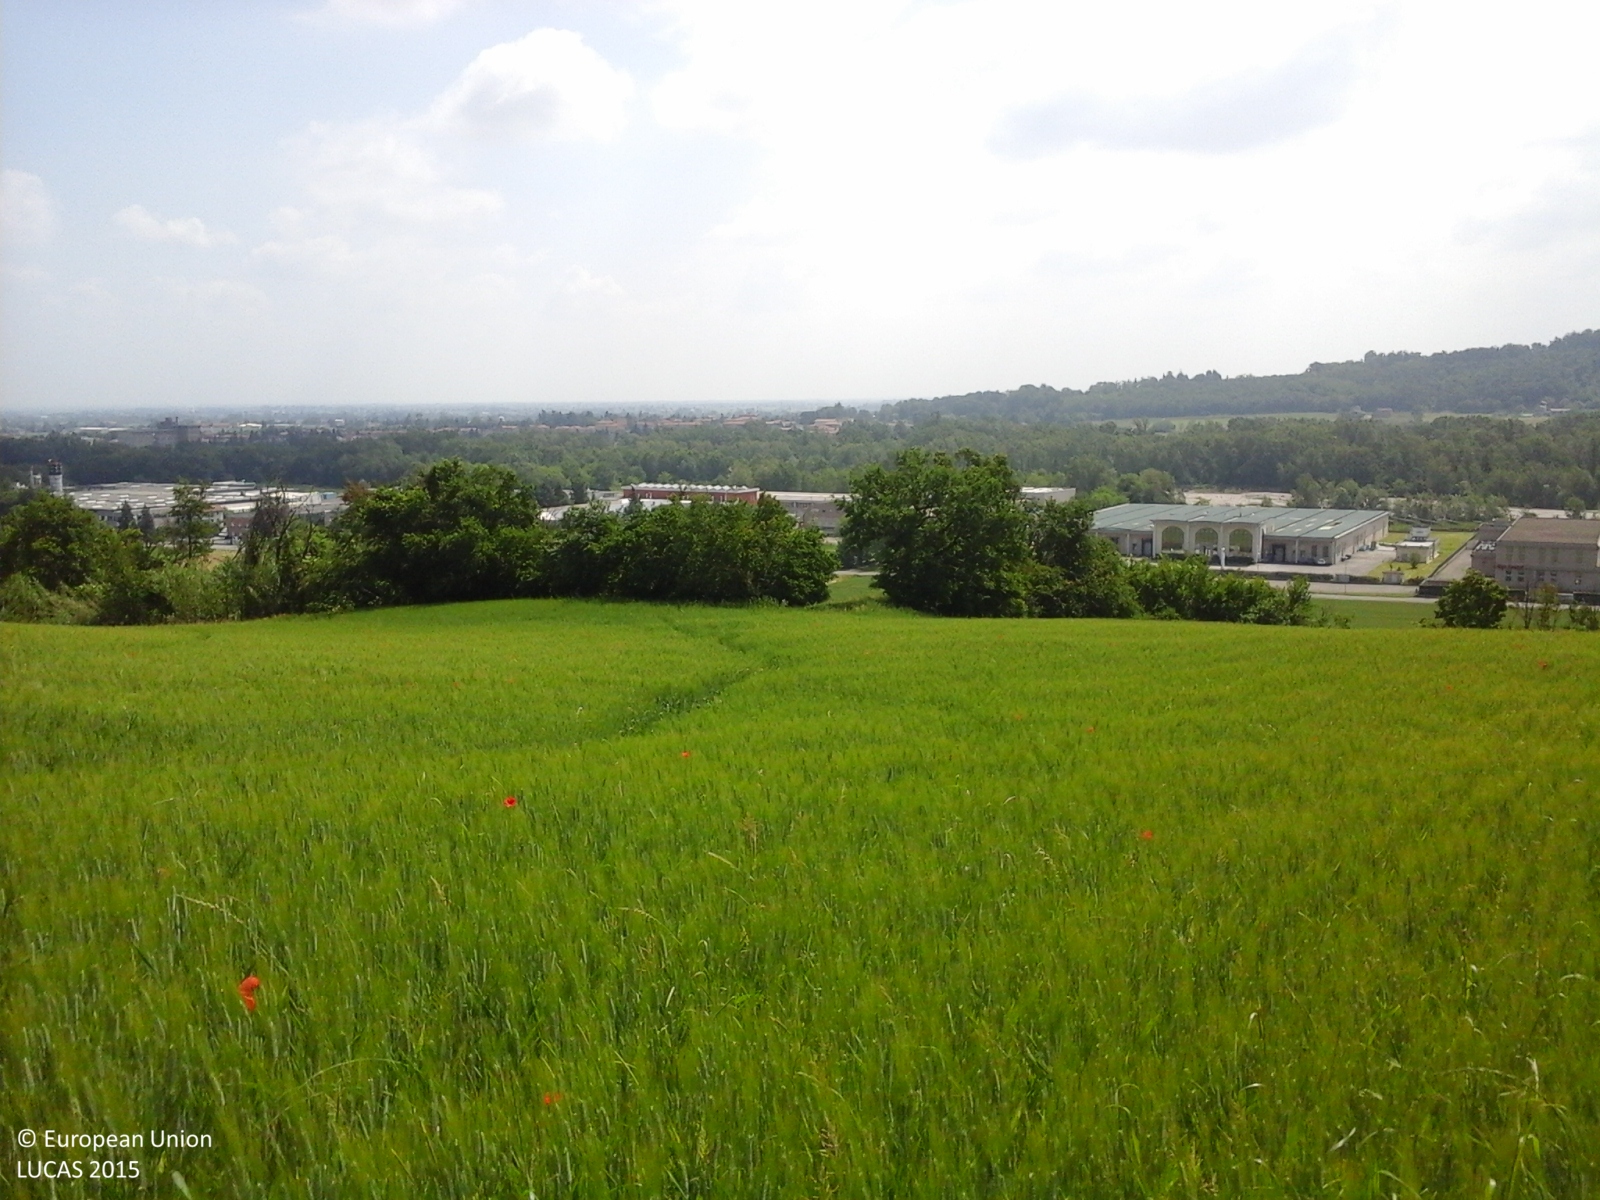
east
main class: Cropland
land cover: Common wheat
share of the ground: > 75 %
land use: Agriculture (excluding fallow land and kitchen gardens)
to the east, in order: Common wheat; Managed hedges; Common wheat; Broadleaved woodland; Lucerne; Electric lines; Lucerne
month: May
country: IT
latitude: 44.6930
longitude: 10.2141
